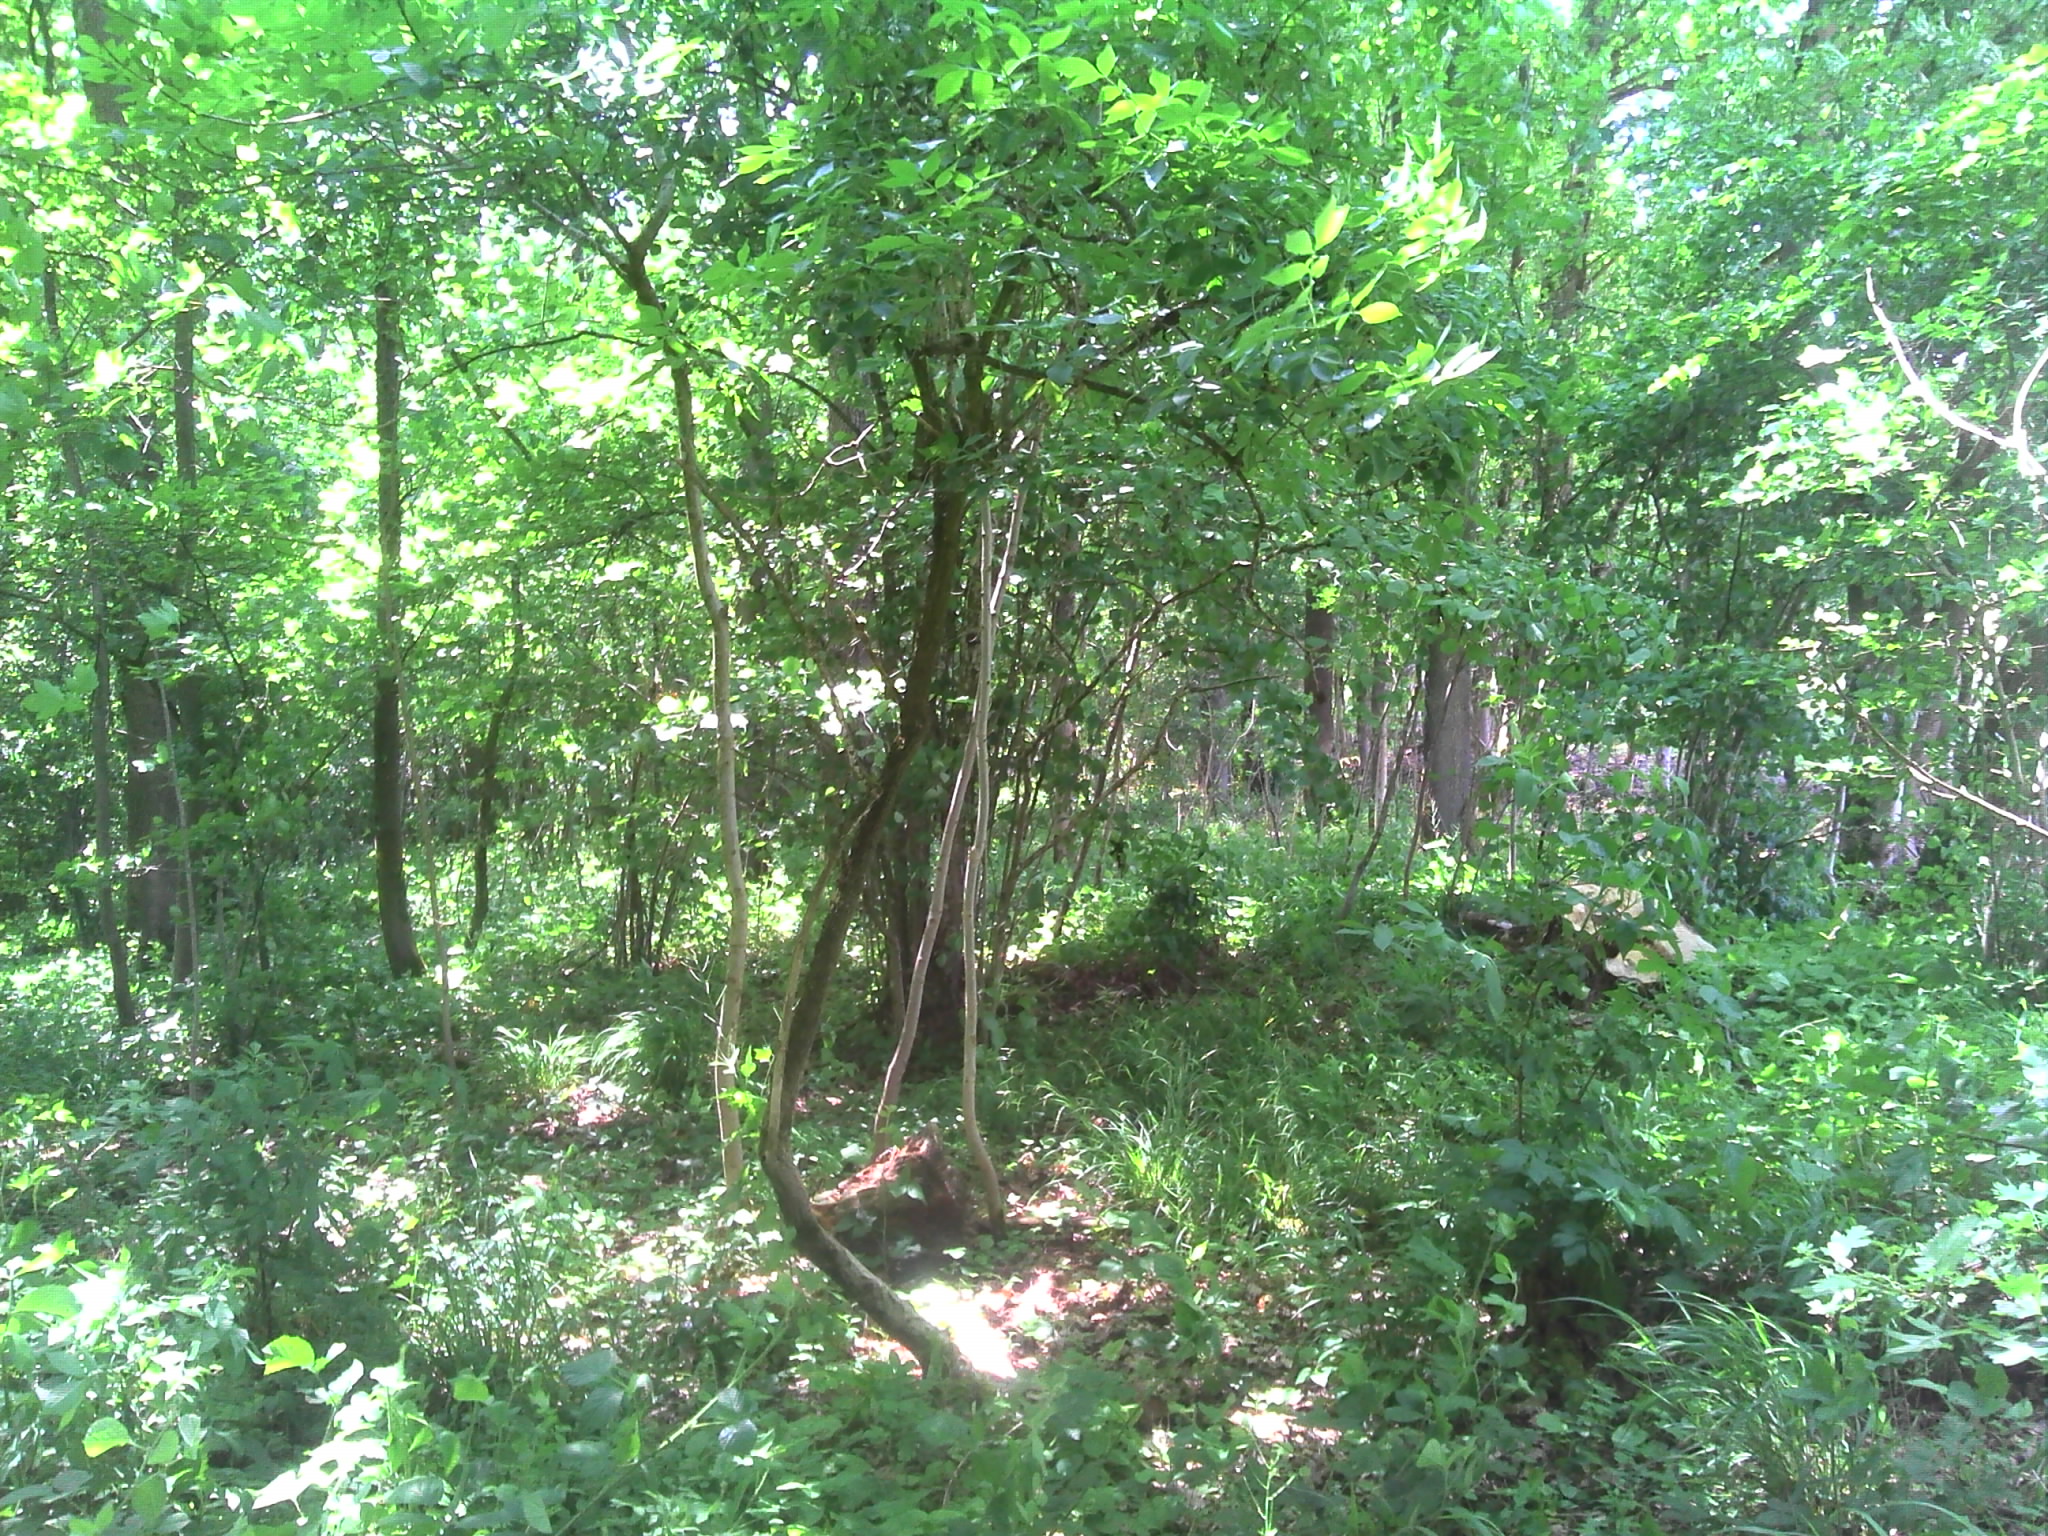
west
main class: Woodland
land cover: Broadleaved woodland
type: mesophytic deciduous forest
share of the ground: > 75 %
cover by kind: broadleaved forest trees 100 %
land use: Forestry
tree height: > 5 m
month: June
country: BE
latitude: 50.2257
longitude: 5.1617
